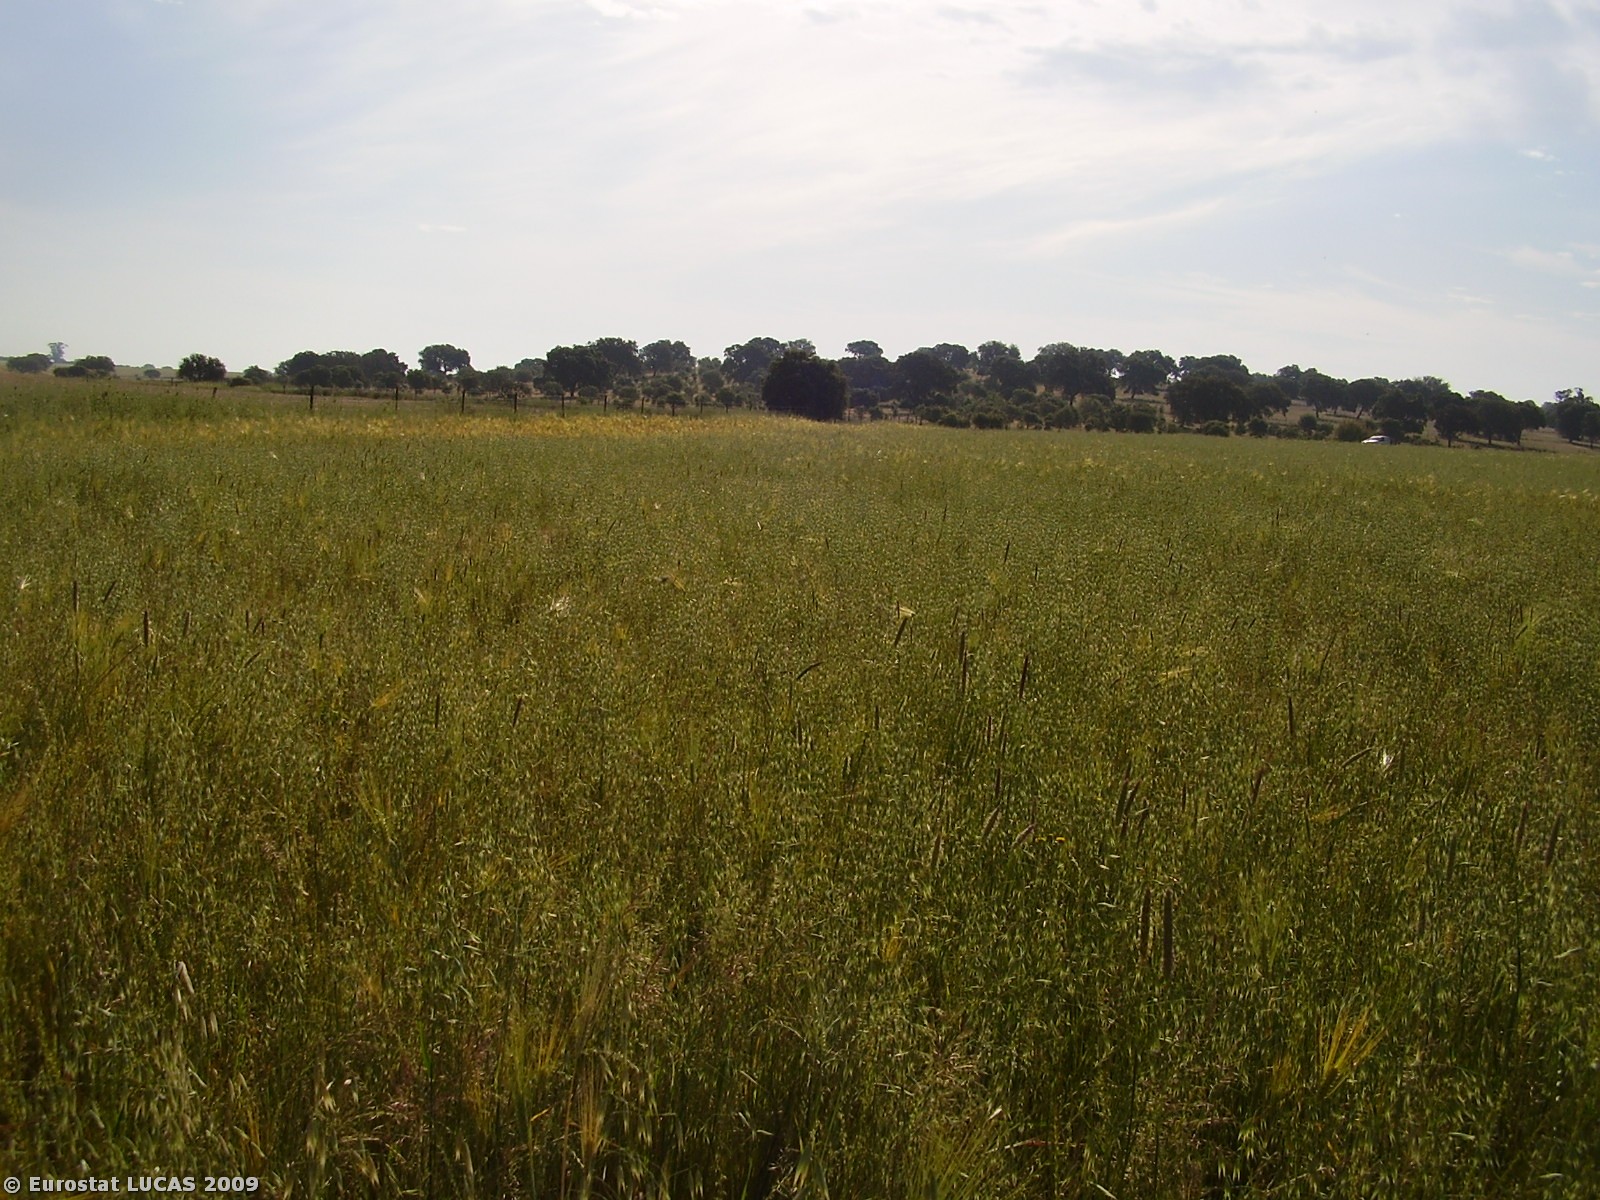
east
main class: Cropland
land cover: Mixed cereals for fodder
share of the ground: > 75 %
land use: Agriculture (excluding fallow land and kitchen gardens)
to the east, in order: Mixed cereals for fodder; Fences; Rivers and streams; Broadleaved woodland
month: May
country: PT
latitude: 37.9531
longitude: -7.9299
